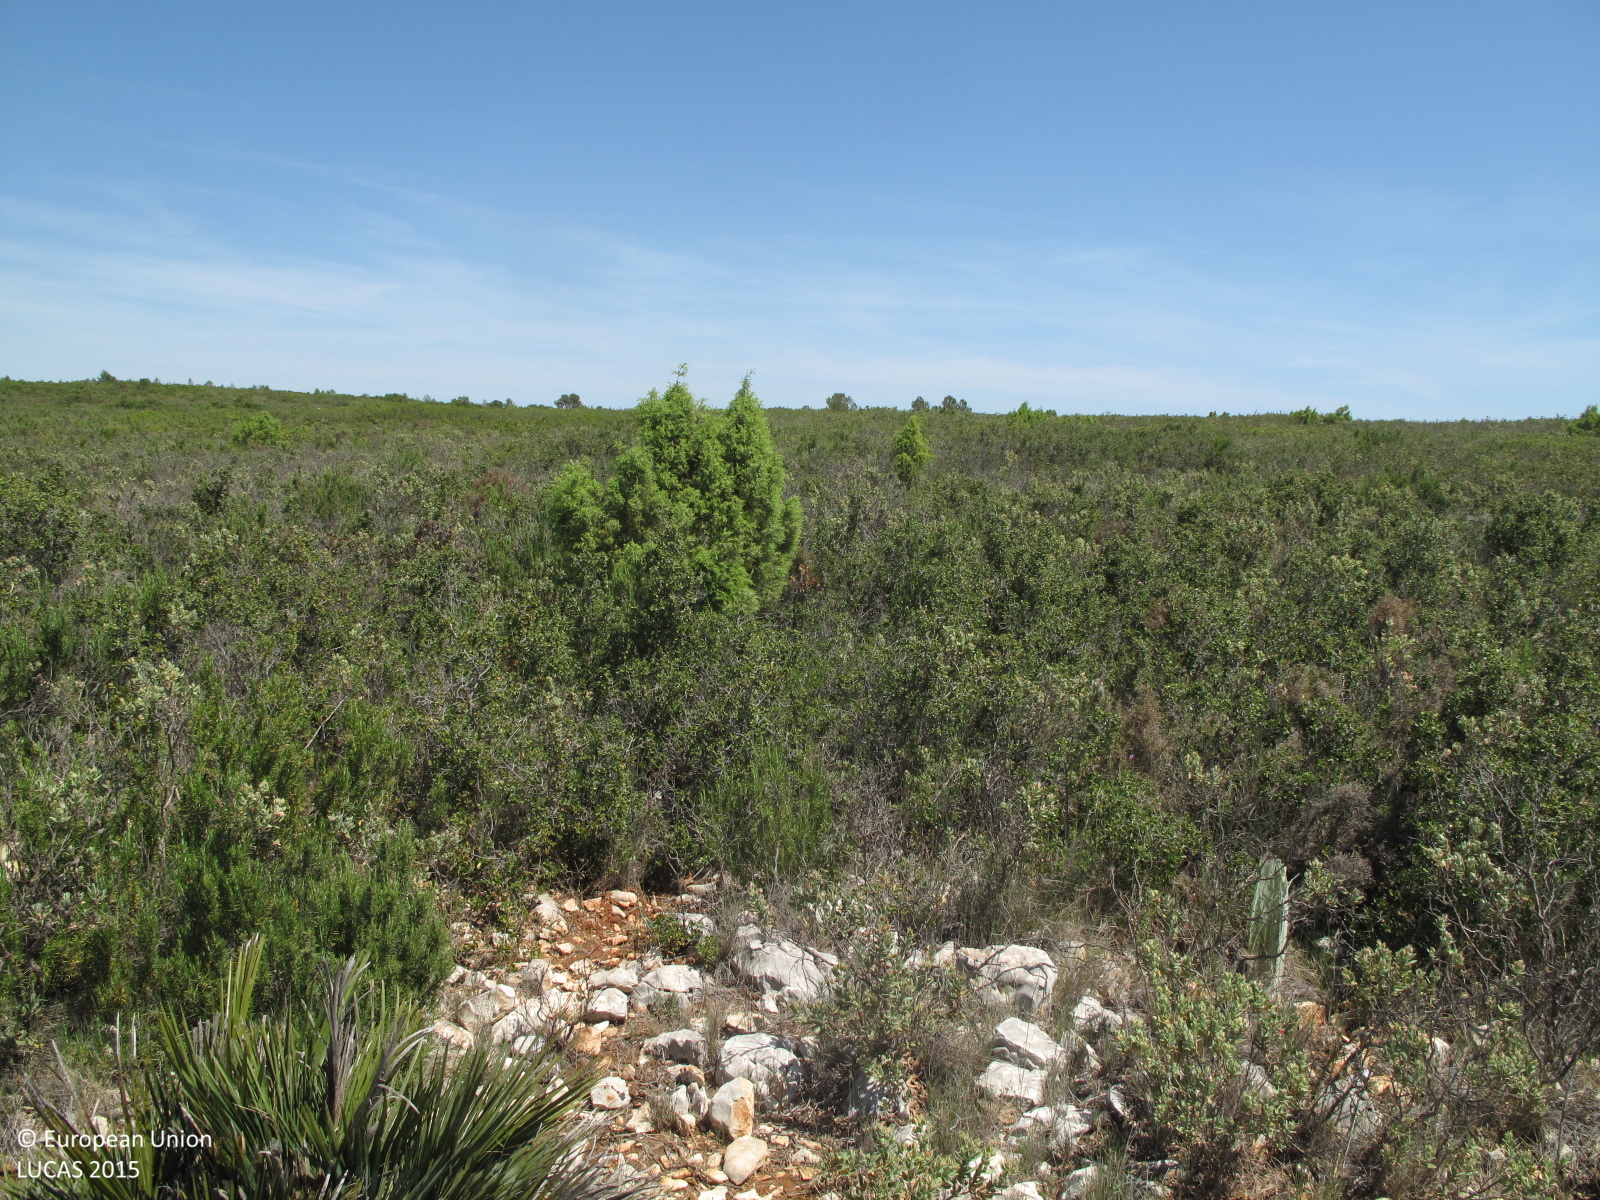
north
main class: Shrubland
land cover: Shrubland without tree cover
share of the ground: 50 - 75 %
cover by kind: shrubs 50 %, consolidated bare surface 30 %, herbaceous plants 20 %
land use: Semi-natural and natural areas not in use
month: May
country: ES
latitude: 38.9416
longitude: -0.7807
